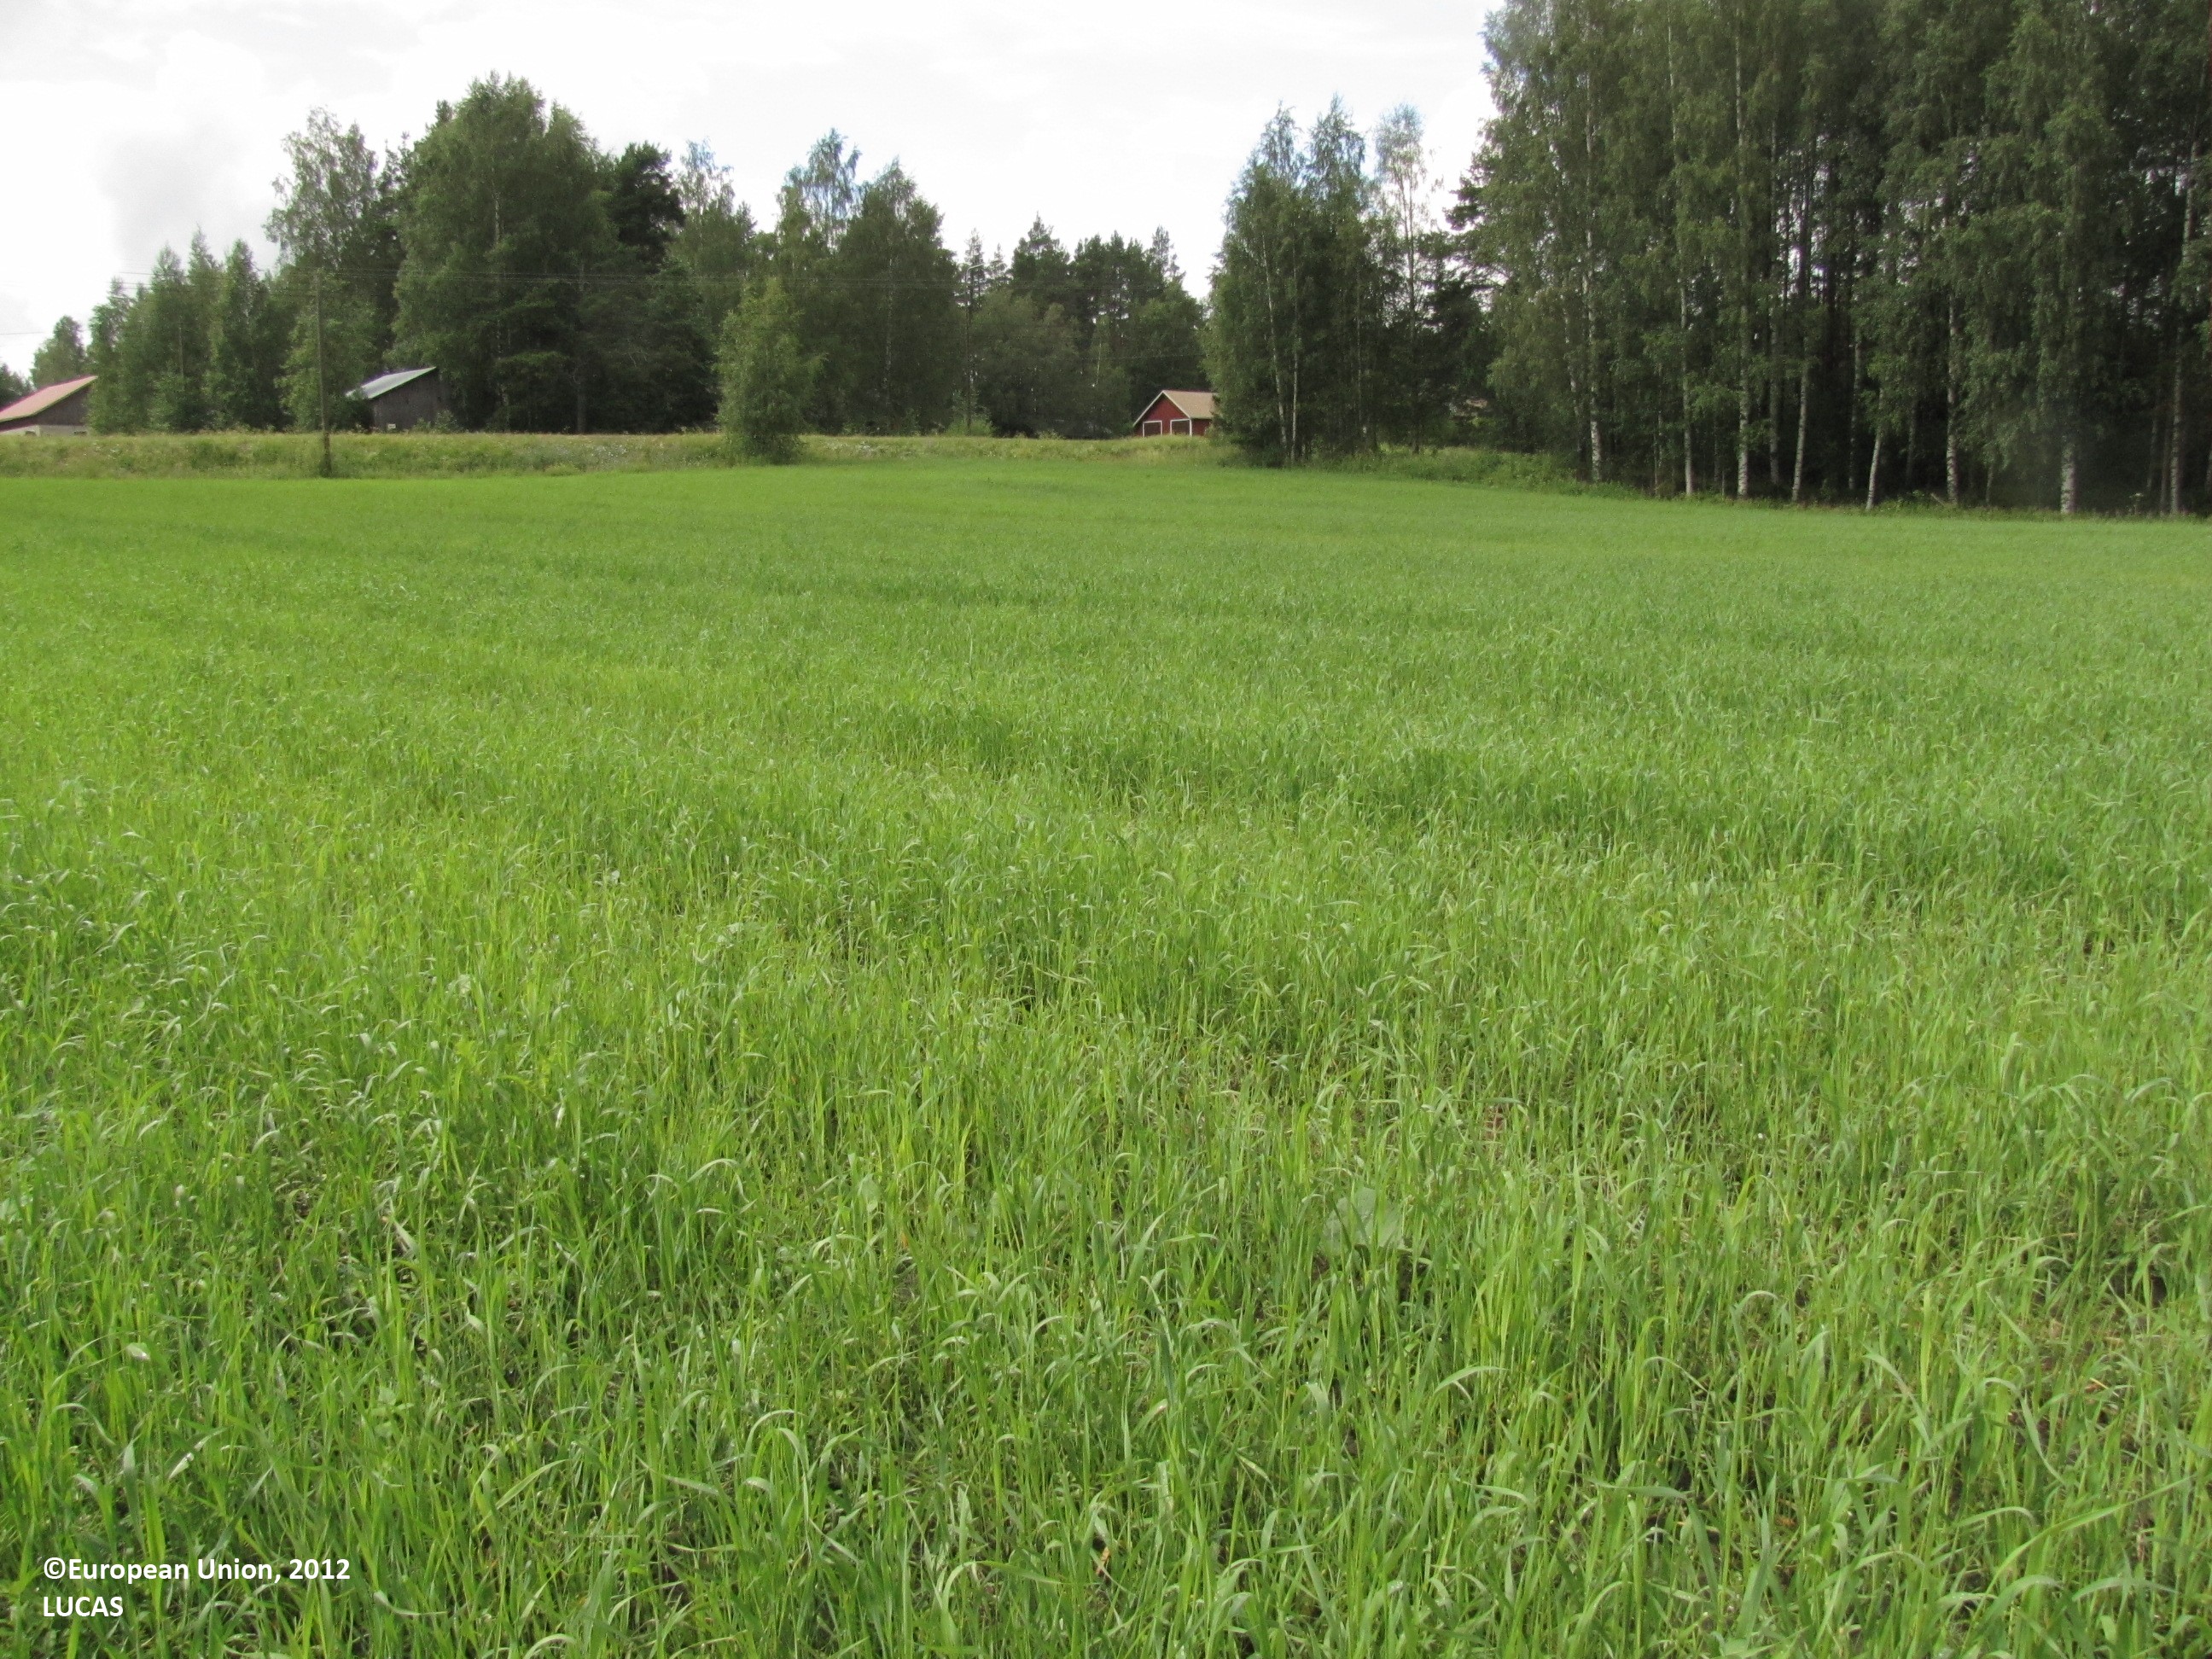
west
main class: Cropland
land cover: Oats
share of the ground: 50 - 75 %
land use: Agriculture (excluding fallow land and kitchen gardens)
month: July
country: FI
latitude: 62.3103
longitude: 23.3221
